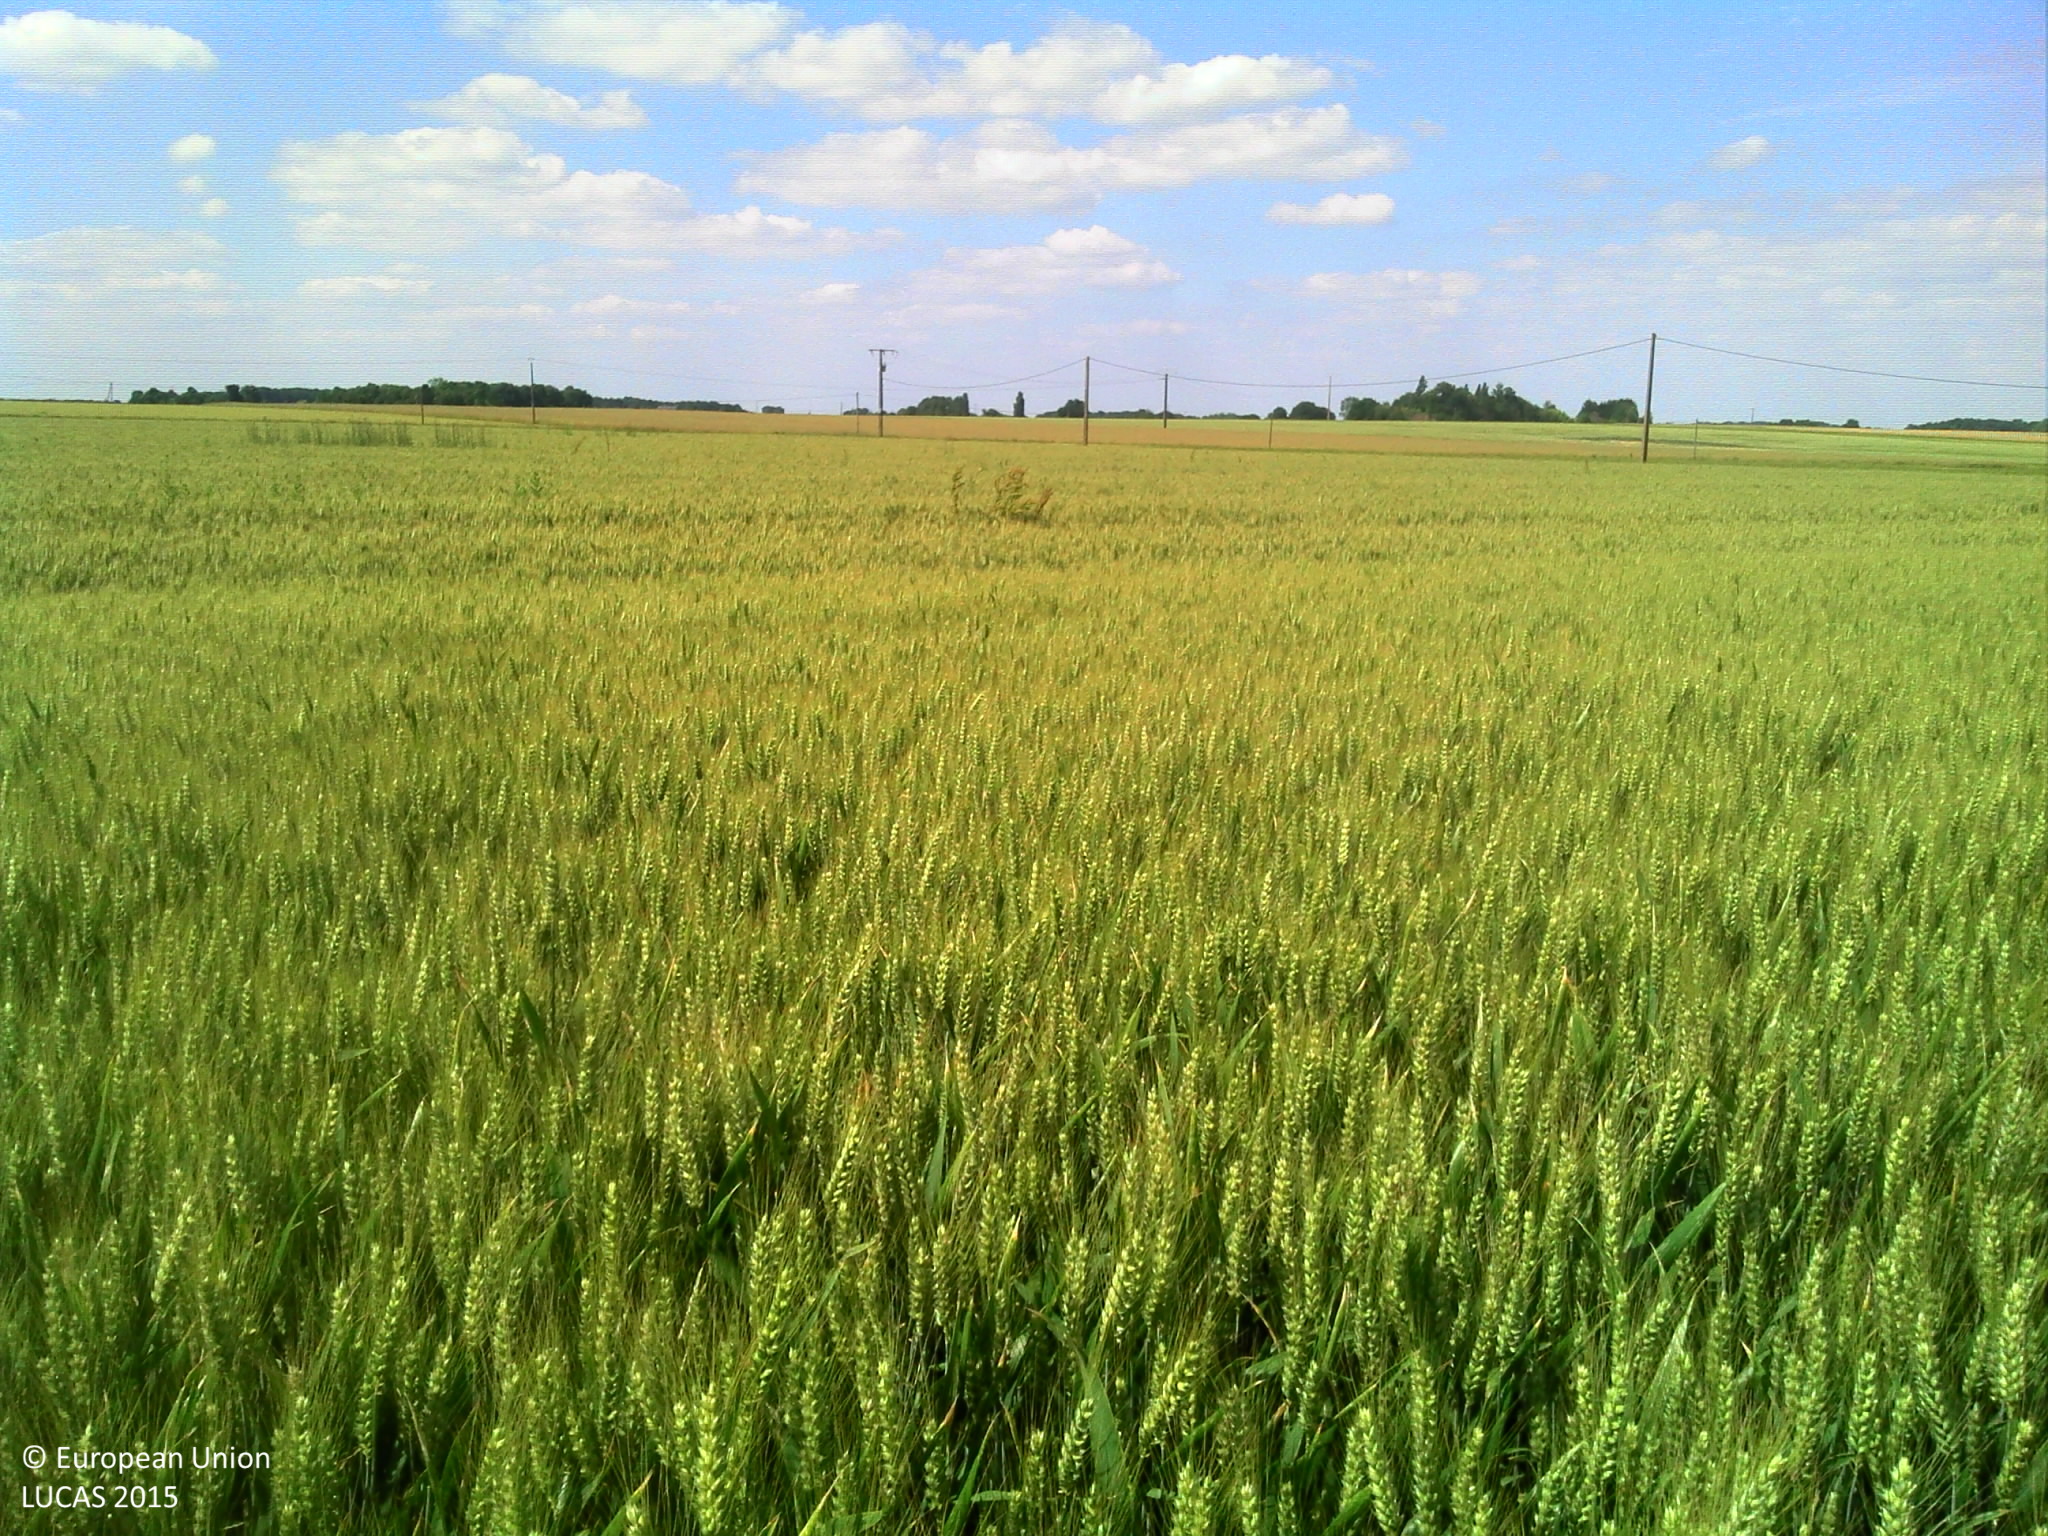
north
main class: Cropland
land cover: Durum wheat
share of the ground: > 75 %
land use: Agriculture (excluding fallow land and kitchen gardens)
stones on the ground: < 10 %
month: June
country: FR
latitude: 47.5567
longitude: 0.4761
